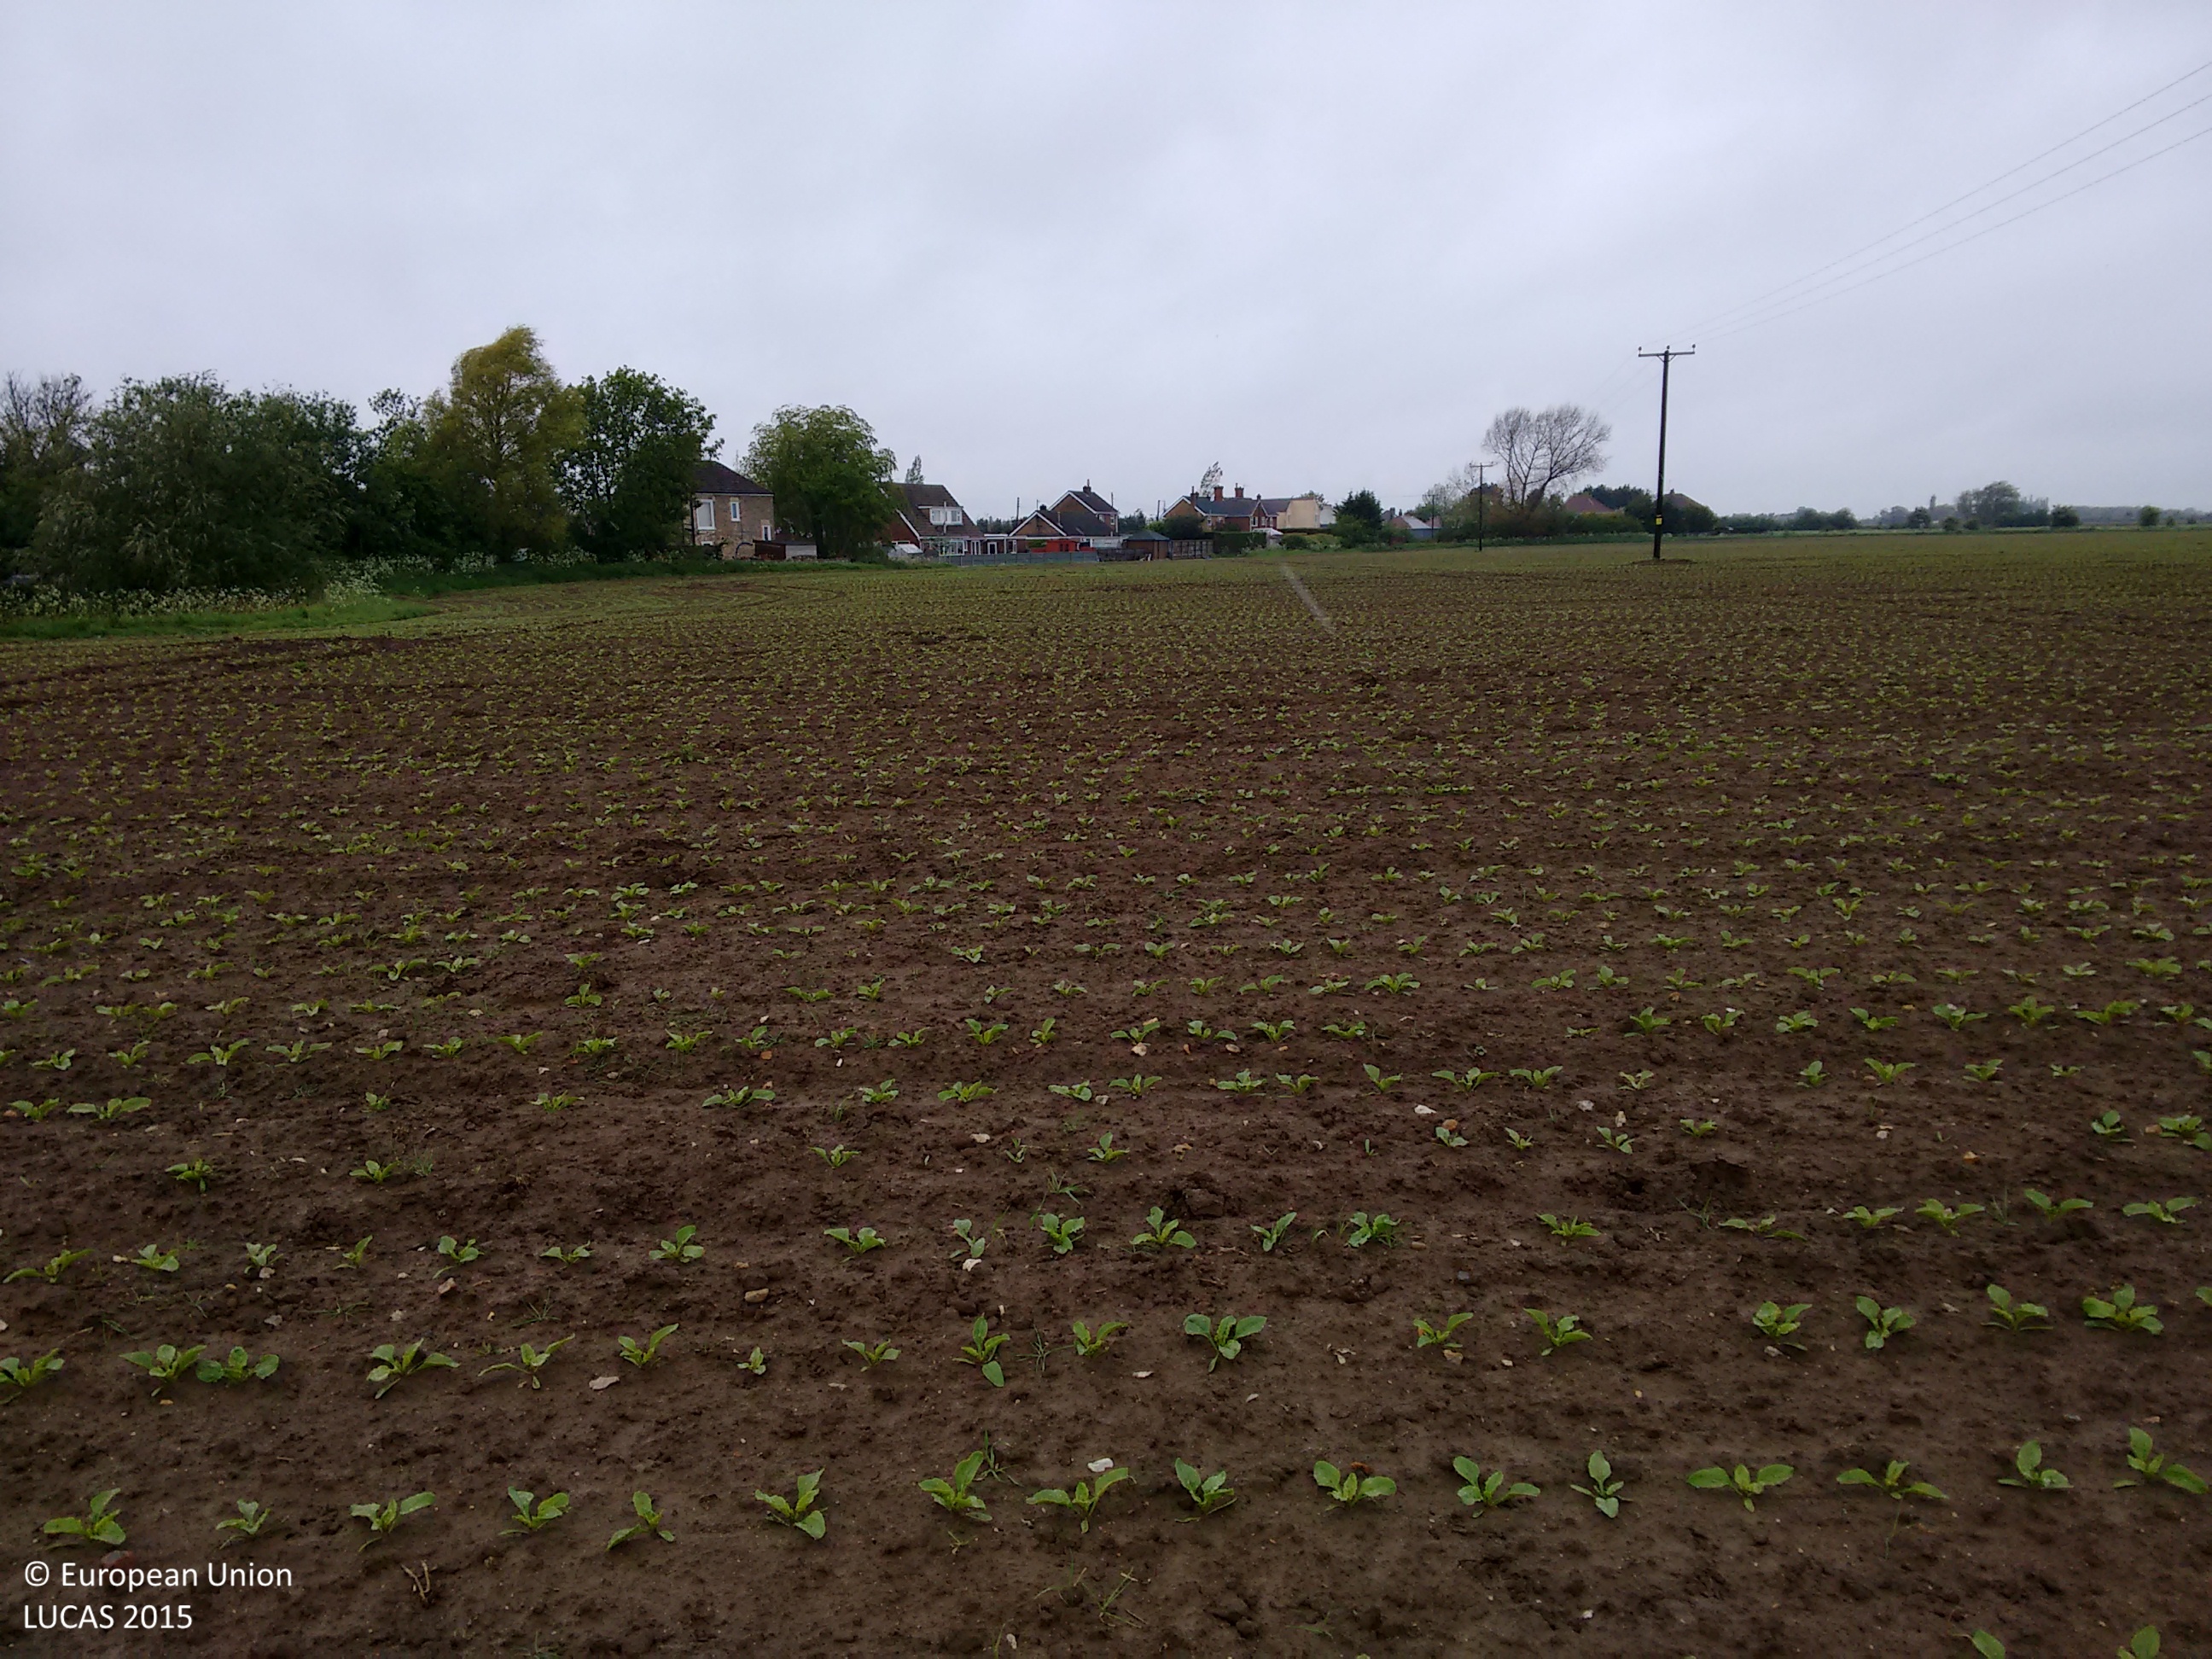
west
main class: Cropland
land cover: Sugar beet
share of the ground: < 10 %
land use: Agriculture (excluding fallow land and kitchen gardens)
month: May
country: GB
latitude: 52.9062
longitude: -0.0992
